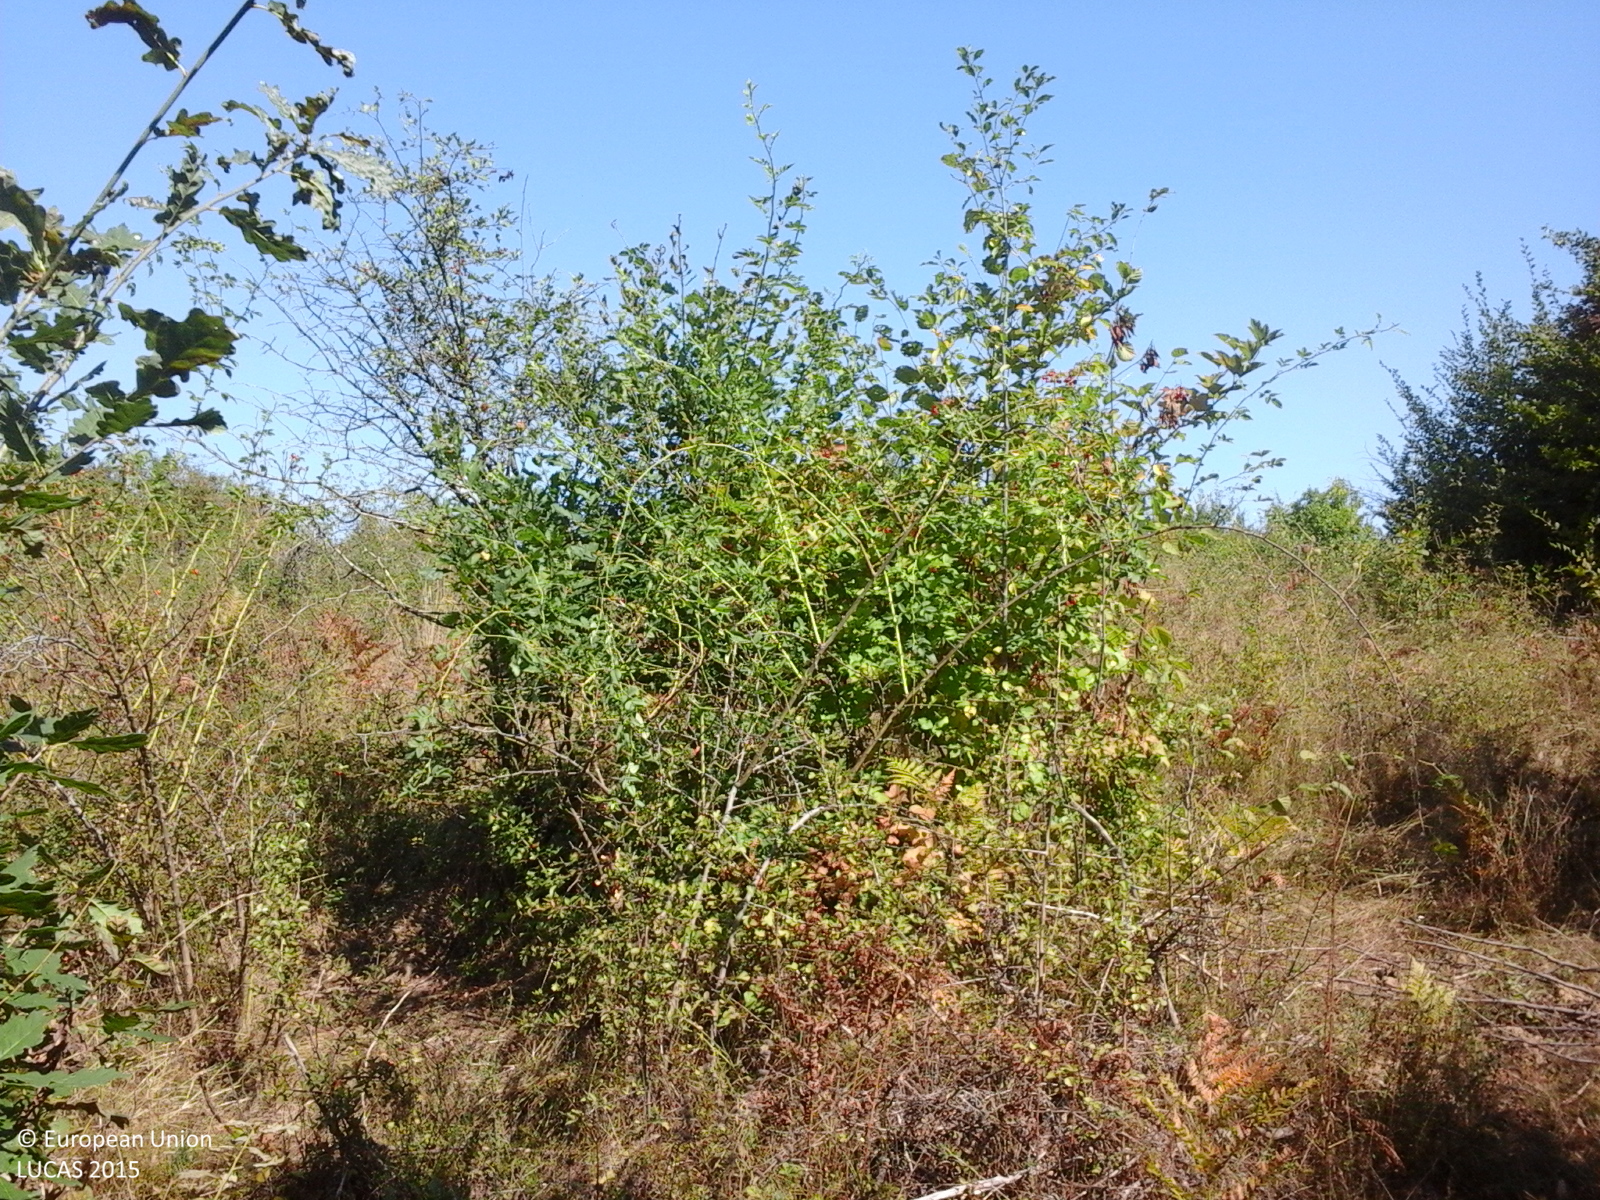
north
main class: Woodland
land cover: Broadleaved woodland
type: beech forest
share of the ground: > 75 %
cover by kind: broadleaved forest trees 100 %
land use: Forestry
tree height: > 5 m
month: September
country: RO
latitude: 47.3717
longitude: 23.4881
